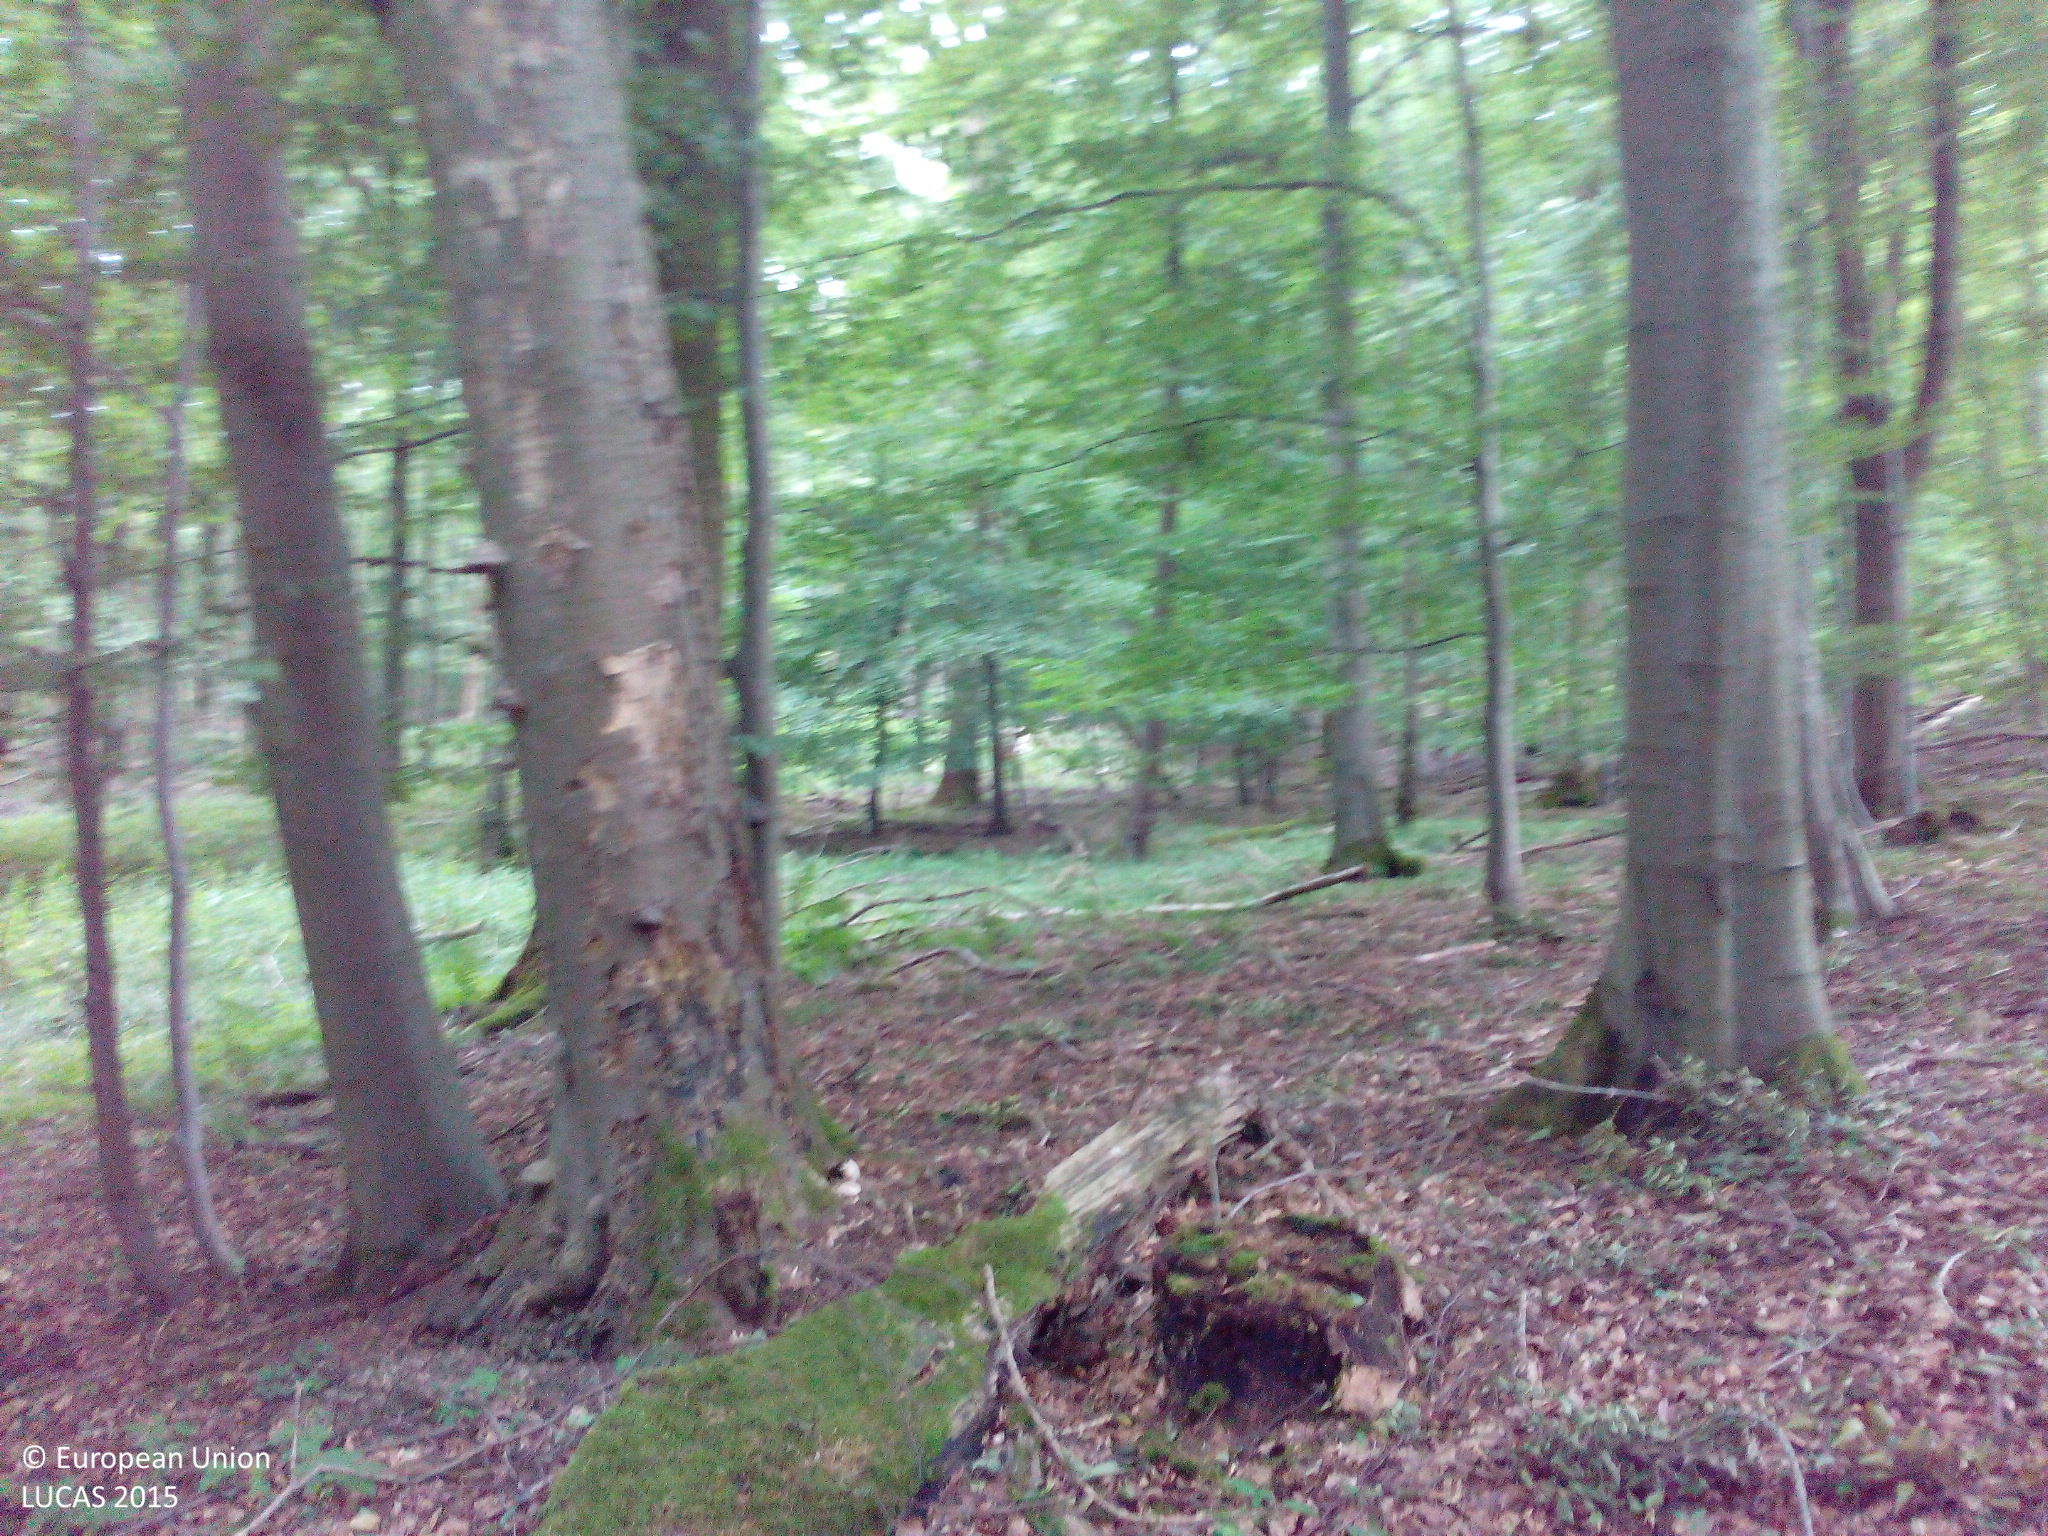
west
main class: Woodland
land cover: Broadleaved woodland
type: beech forest
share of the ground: > 75 %
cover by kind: broadleaved forest trees 95 %, herbaceous plants 5 %
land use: Forestry
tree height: > 5 m
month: August
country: DE
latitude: 51.8896
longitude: 9.2302
